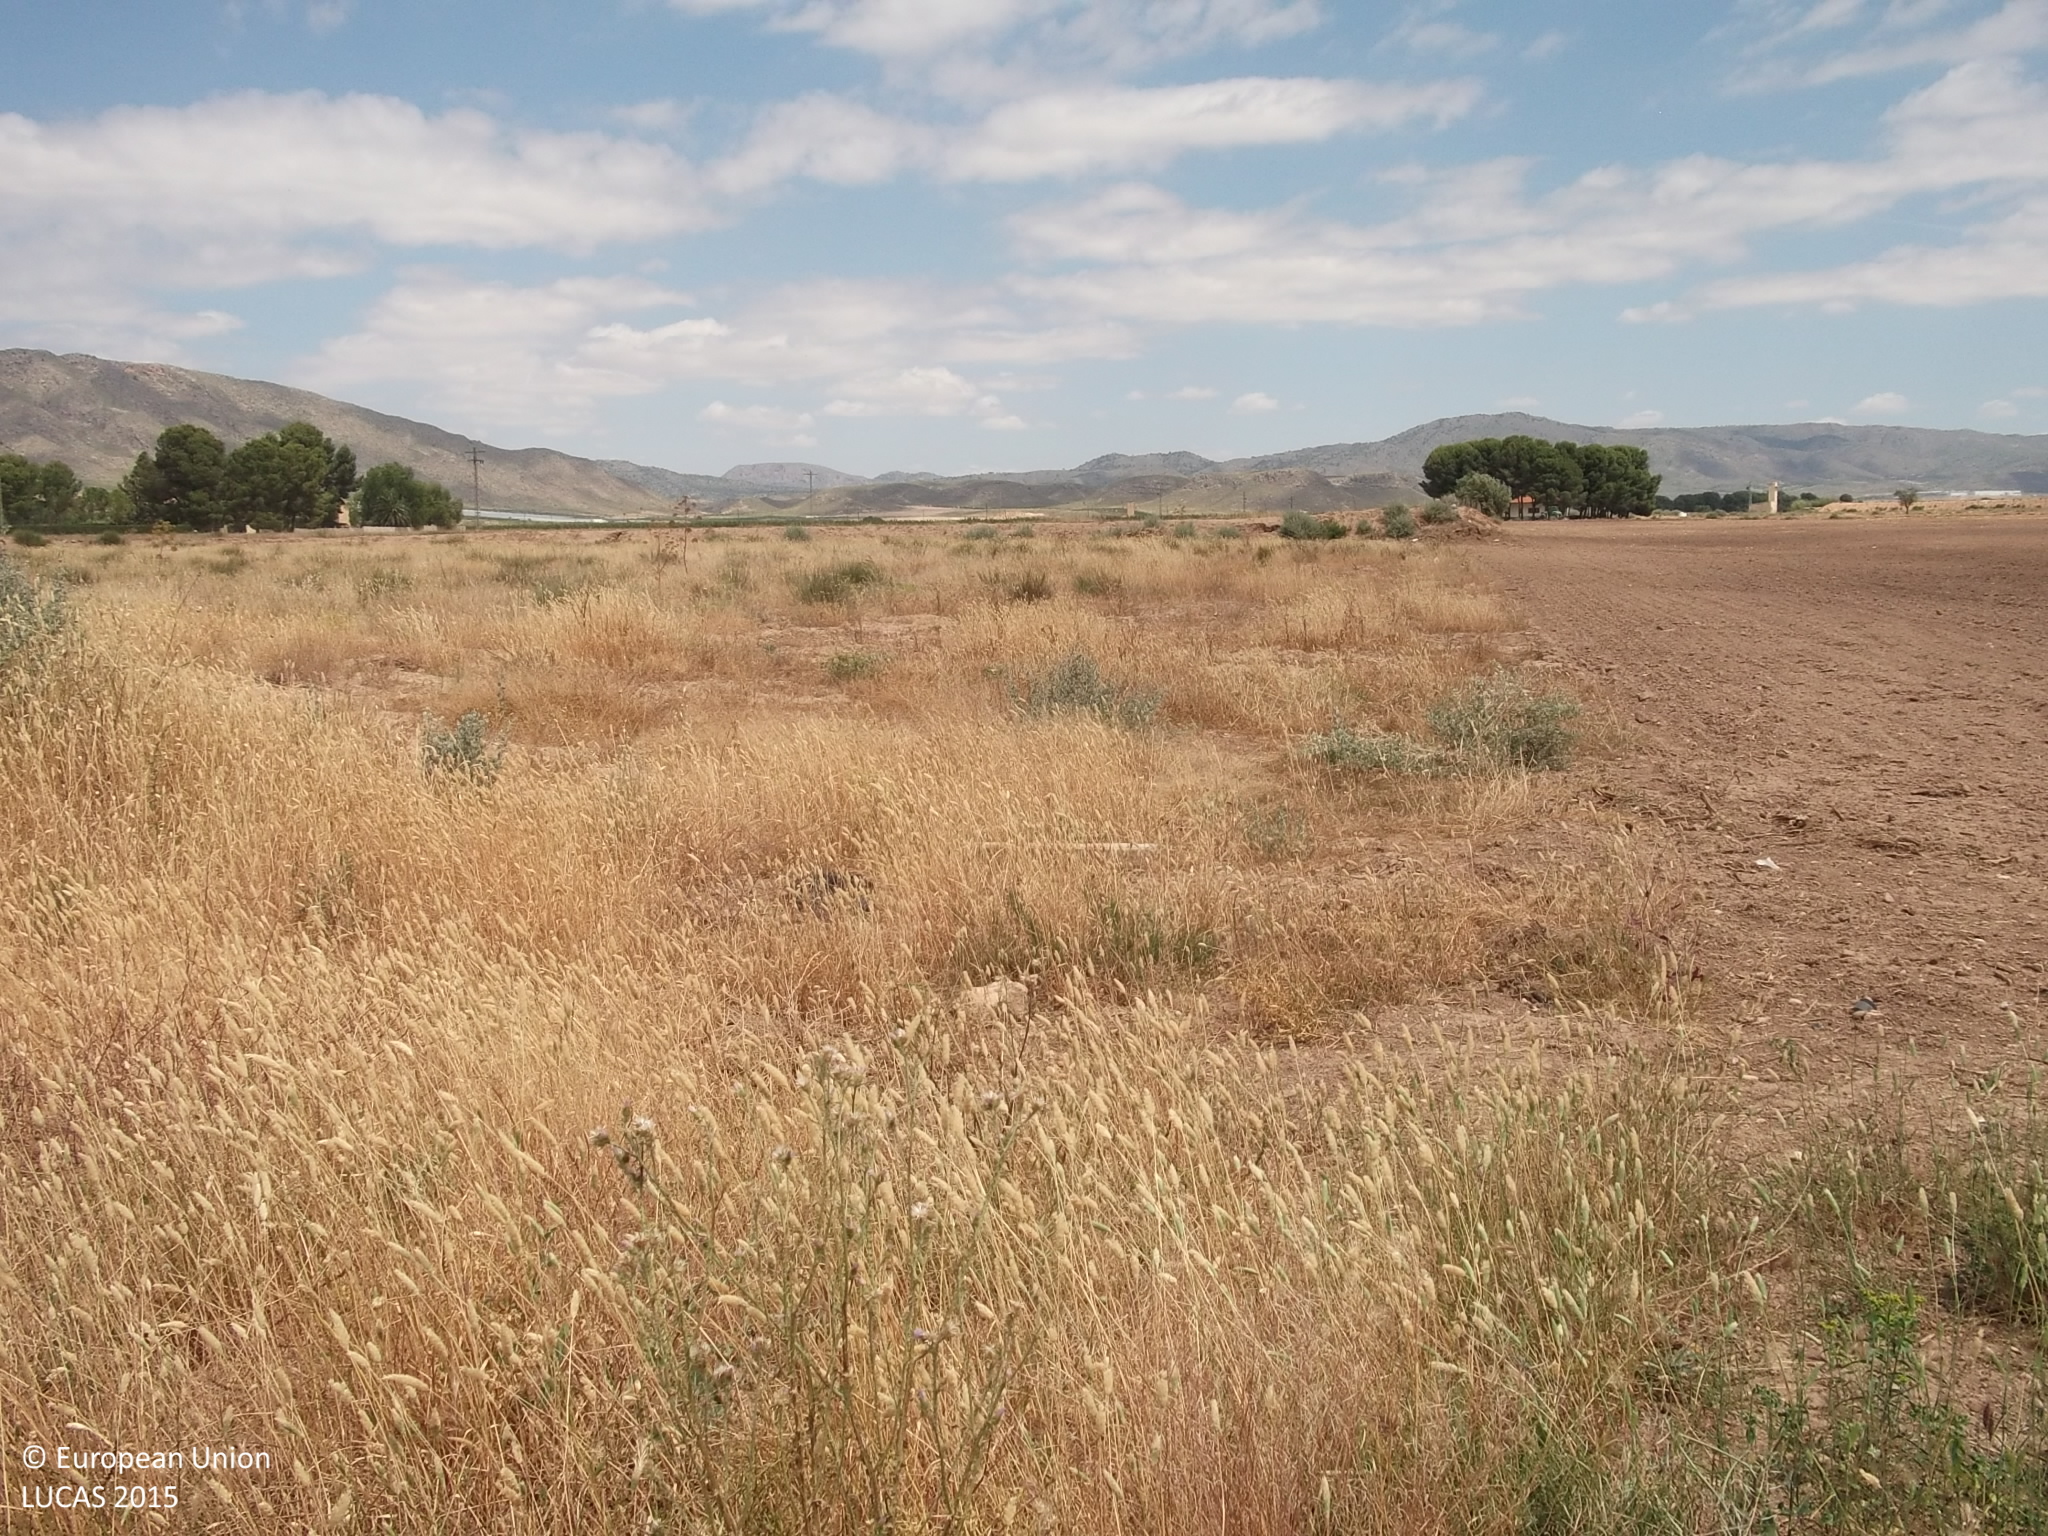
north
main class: Shrubland
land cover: Shrubland without tree cover
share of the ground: 10 - 25 %
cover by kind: herbaceous plants 40 %, consolidated bare surface 40 %, shrubs 20 %
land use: Semi-natural and natural areas not in use
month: May
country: ES
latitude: 38.3530
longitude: -1.4445
